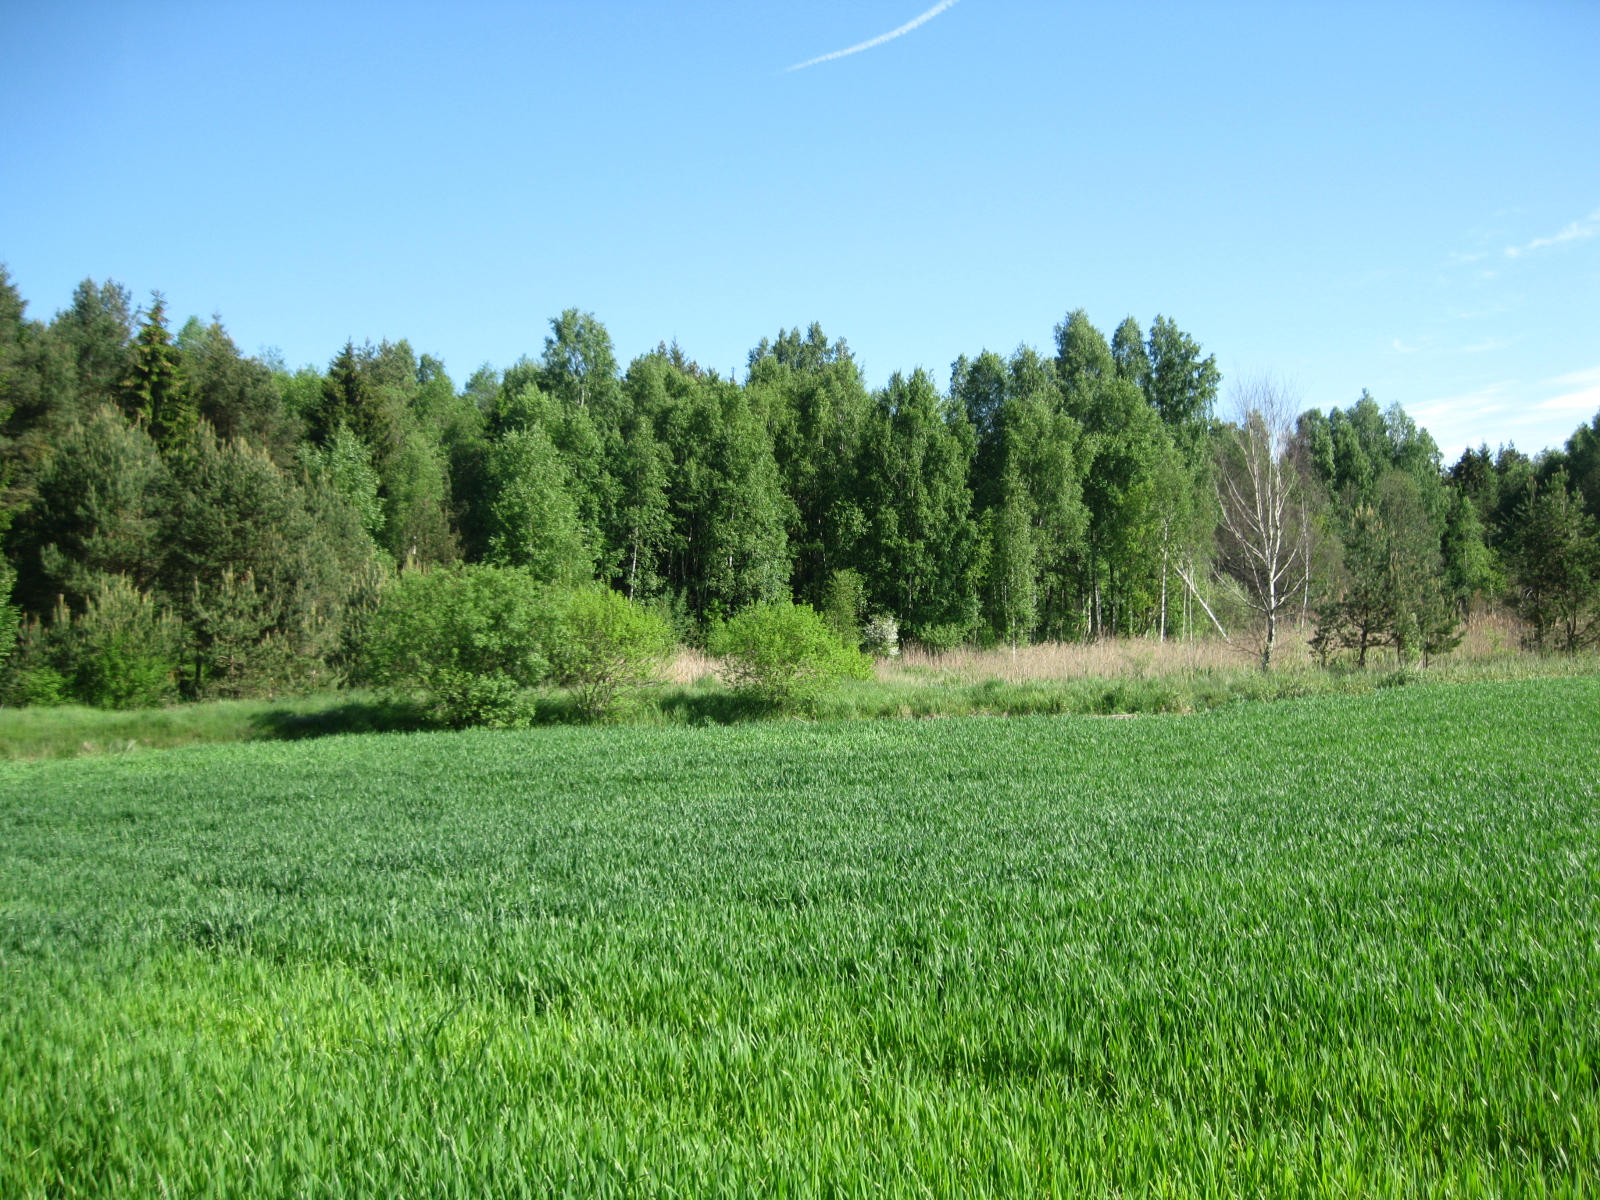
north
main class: Cropland
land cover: Common wheat
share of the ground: > 75 %
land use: Agriculture (excluding fallow land and kitchen gardens)
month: May
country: LT
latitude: 55.8359
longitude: 24.3215
